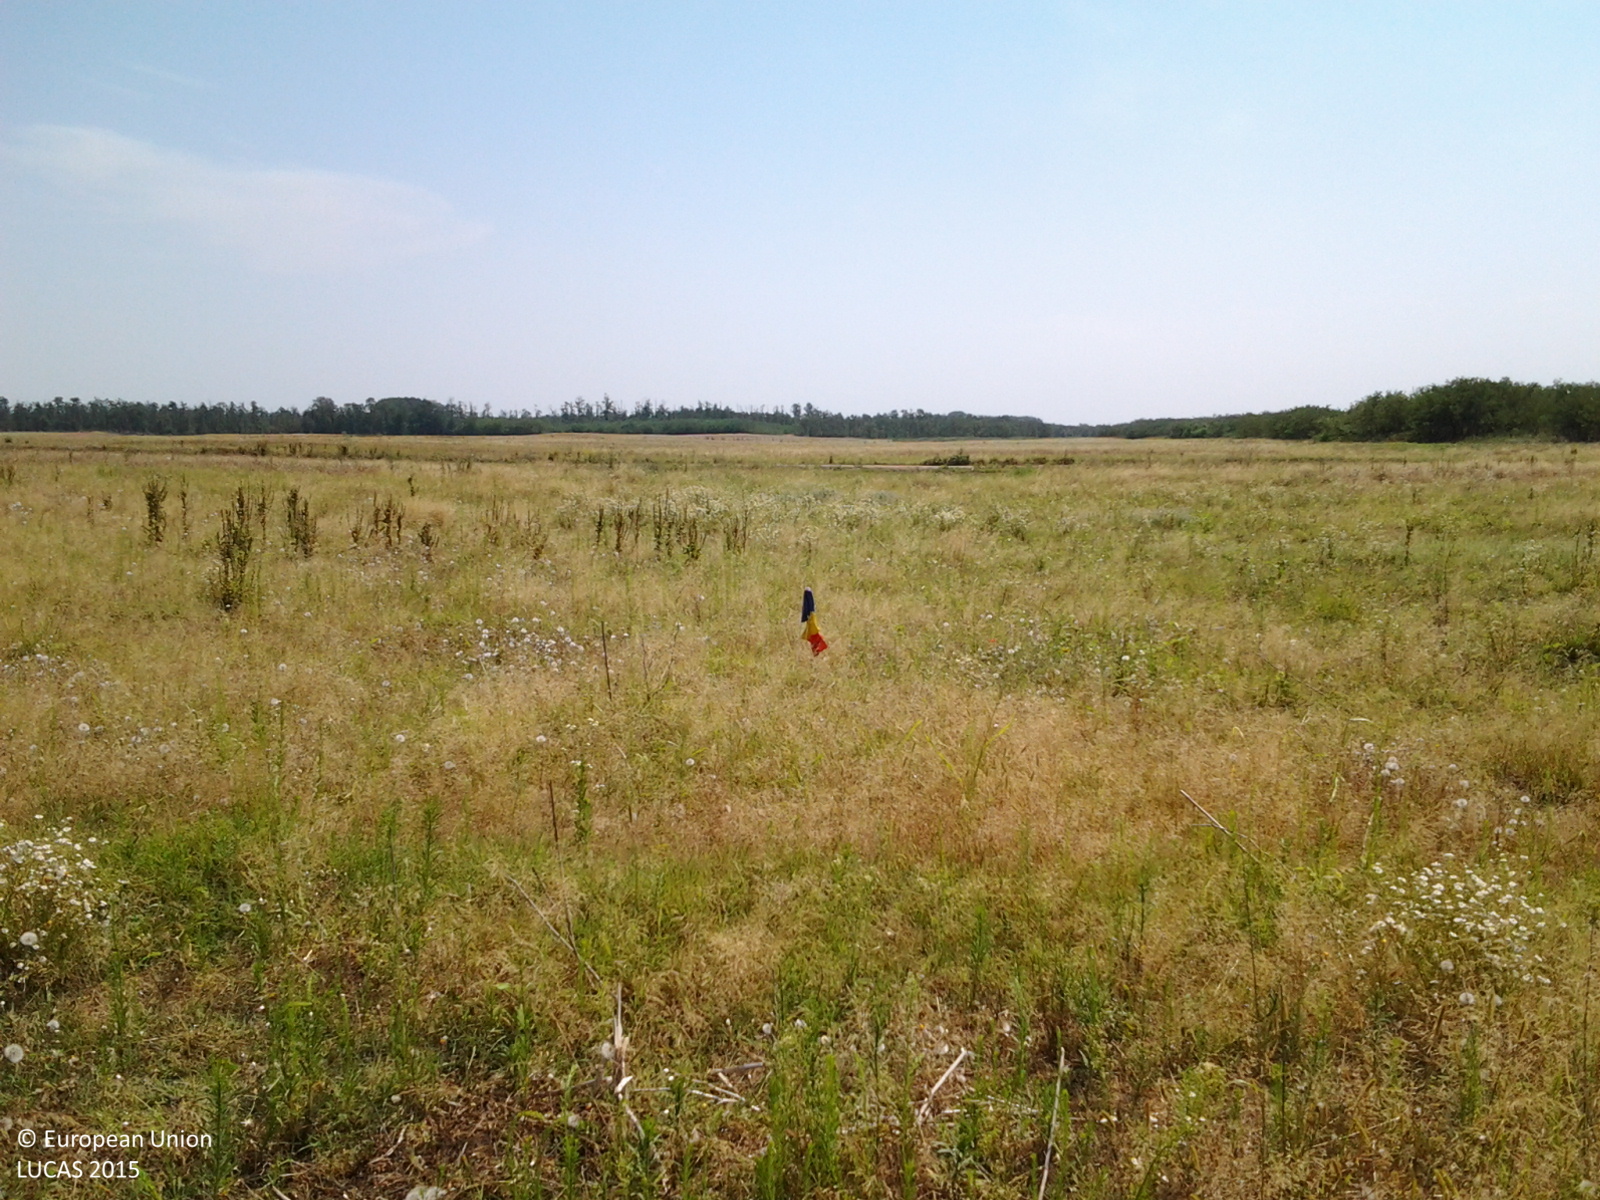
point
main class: Grassland
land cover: Grassland without tree/shrub cover
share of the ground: > 75 %
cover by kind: herbaceous plants 100 %
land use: Agriculture (excluding fallow land and kitchen gardens)
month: August
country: RO
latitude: 43.8824
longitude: 22.9465
